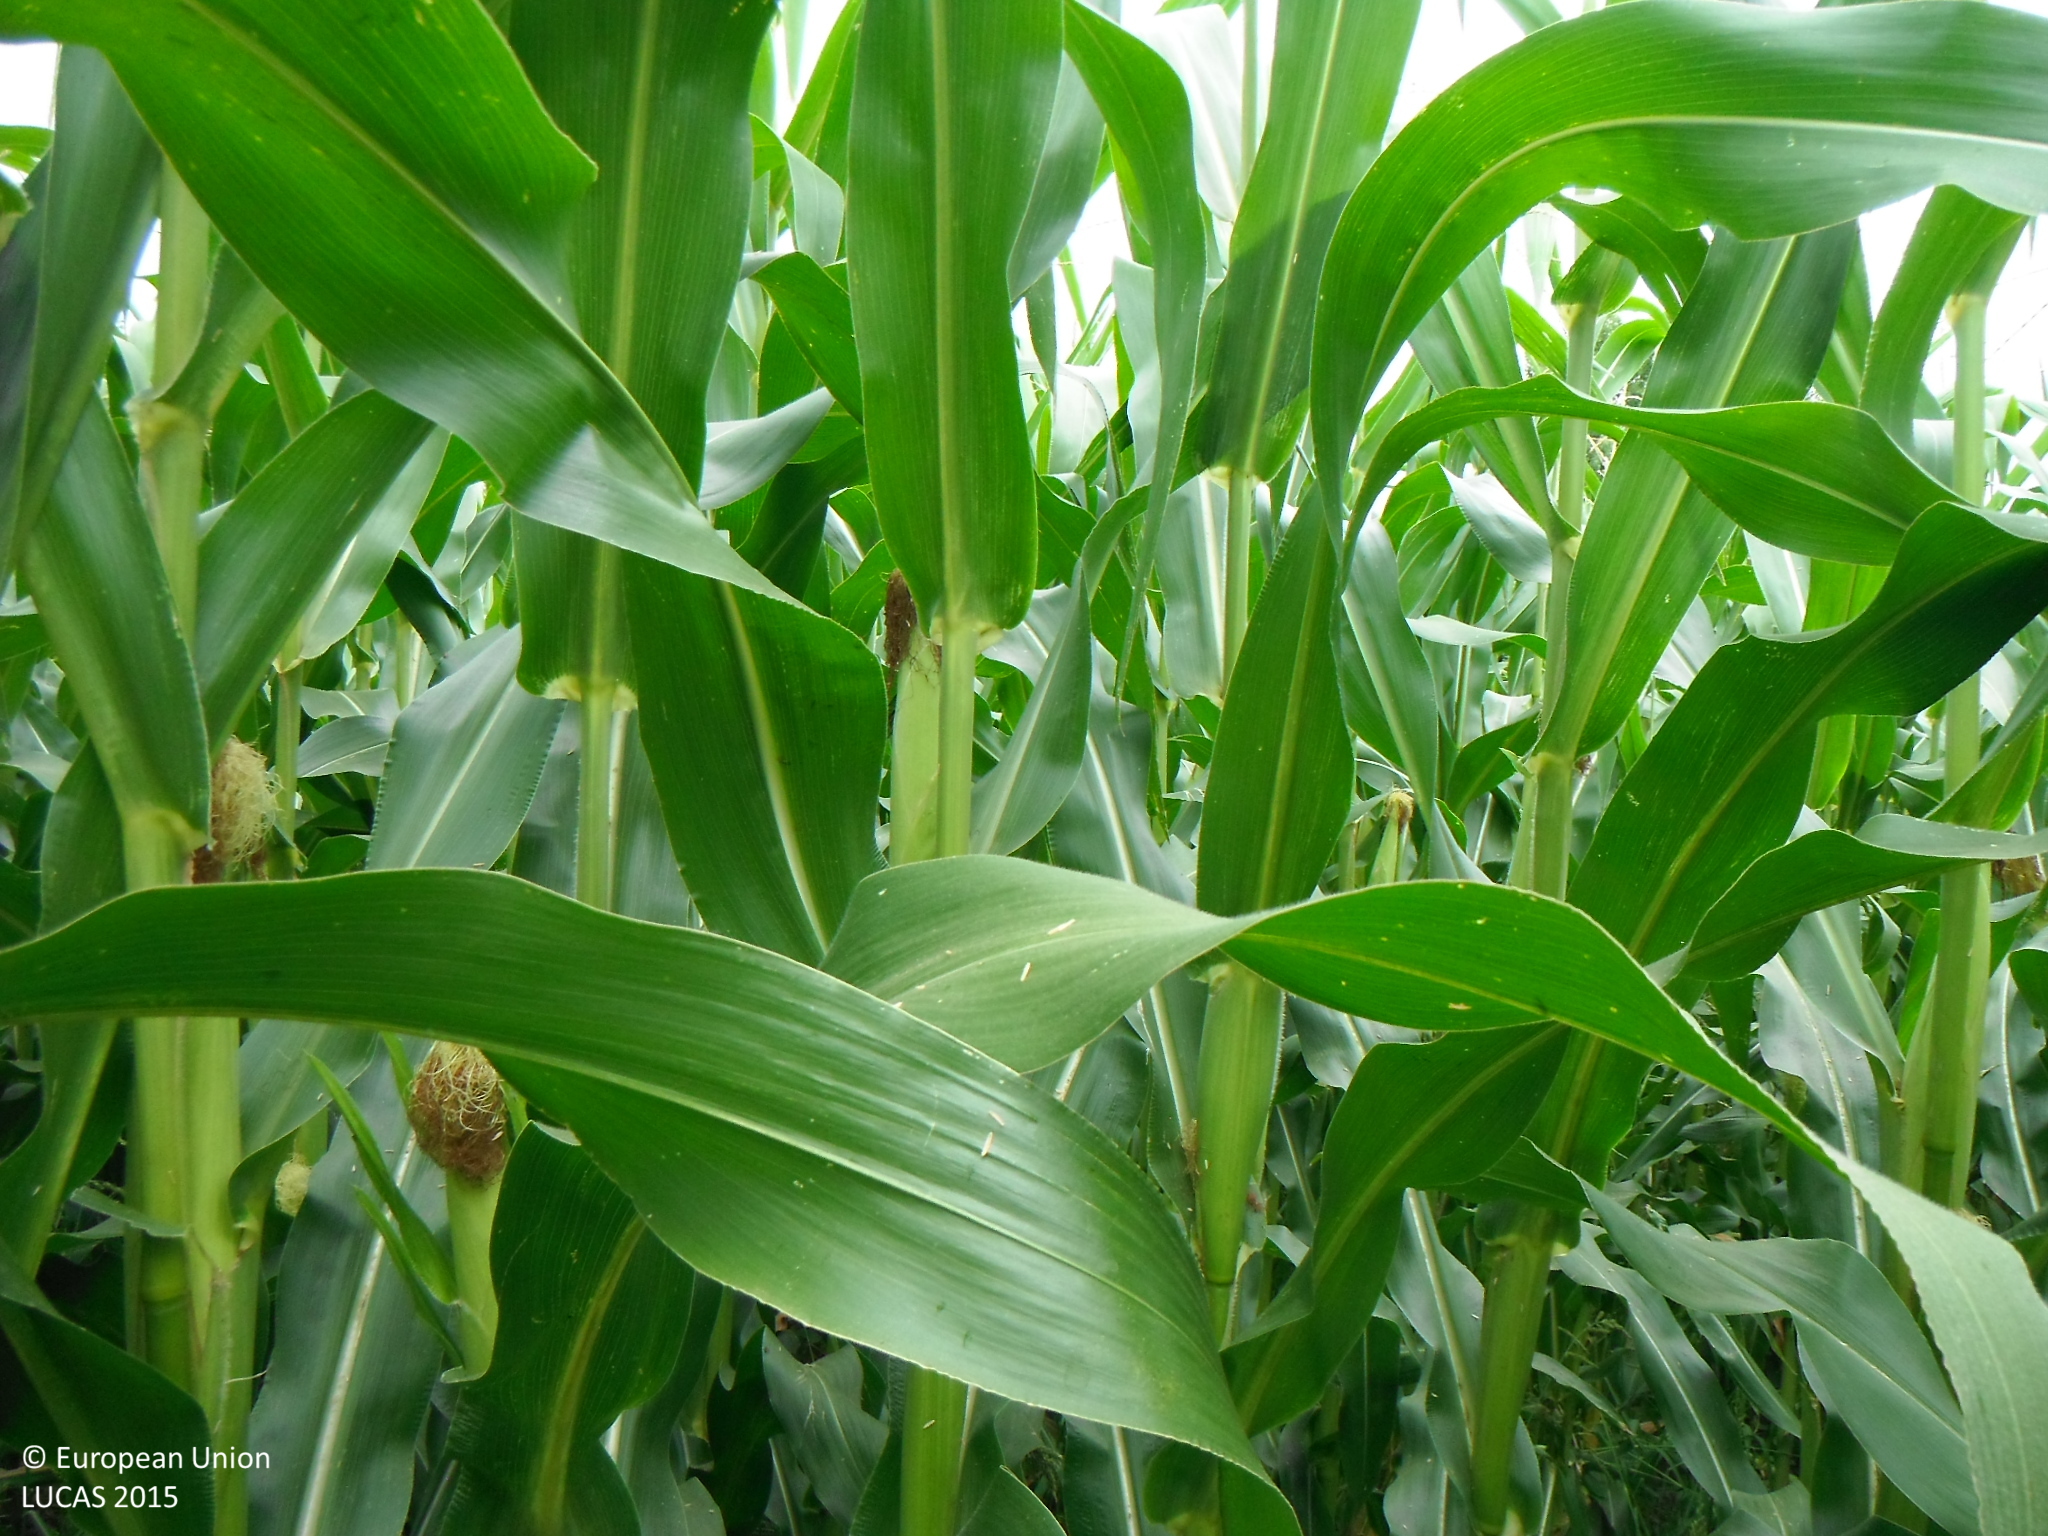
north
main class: Cropland
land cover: Maize
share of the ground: > 75 %
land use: Agriculture (excluding fallow land and kitchen gardens)
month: July
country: SK
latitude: 48.1698
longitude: 19.9653
